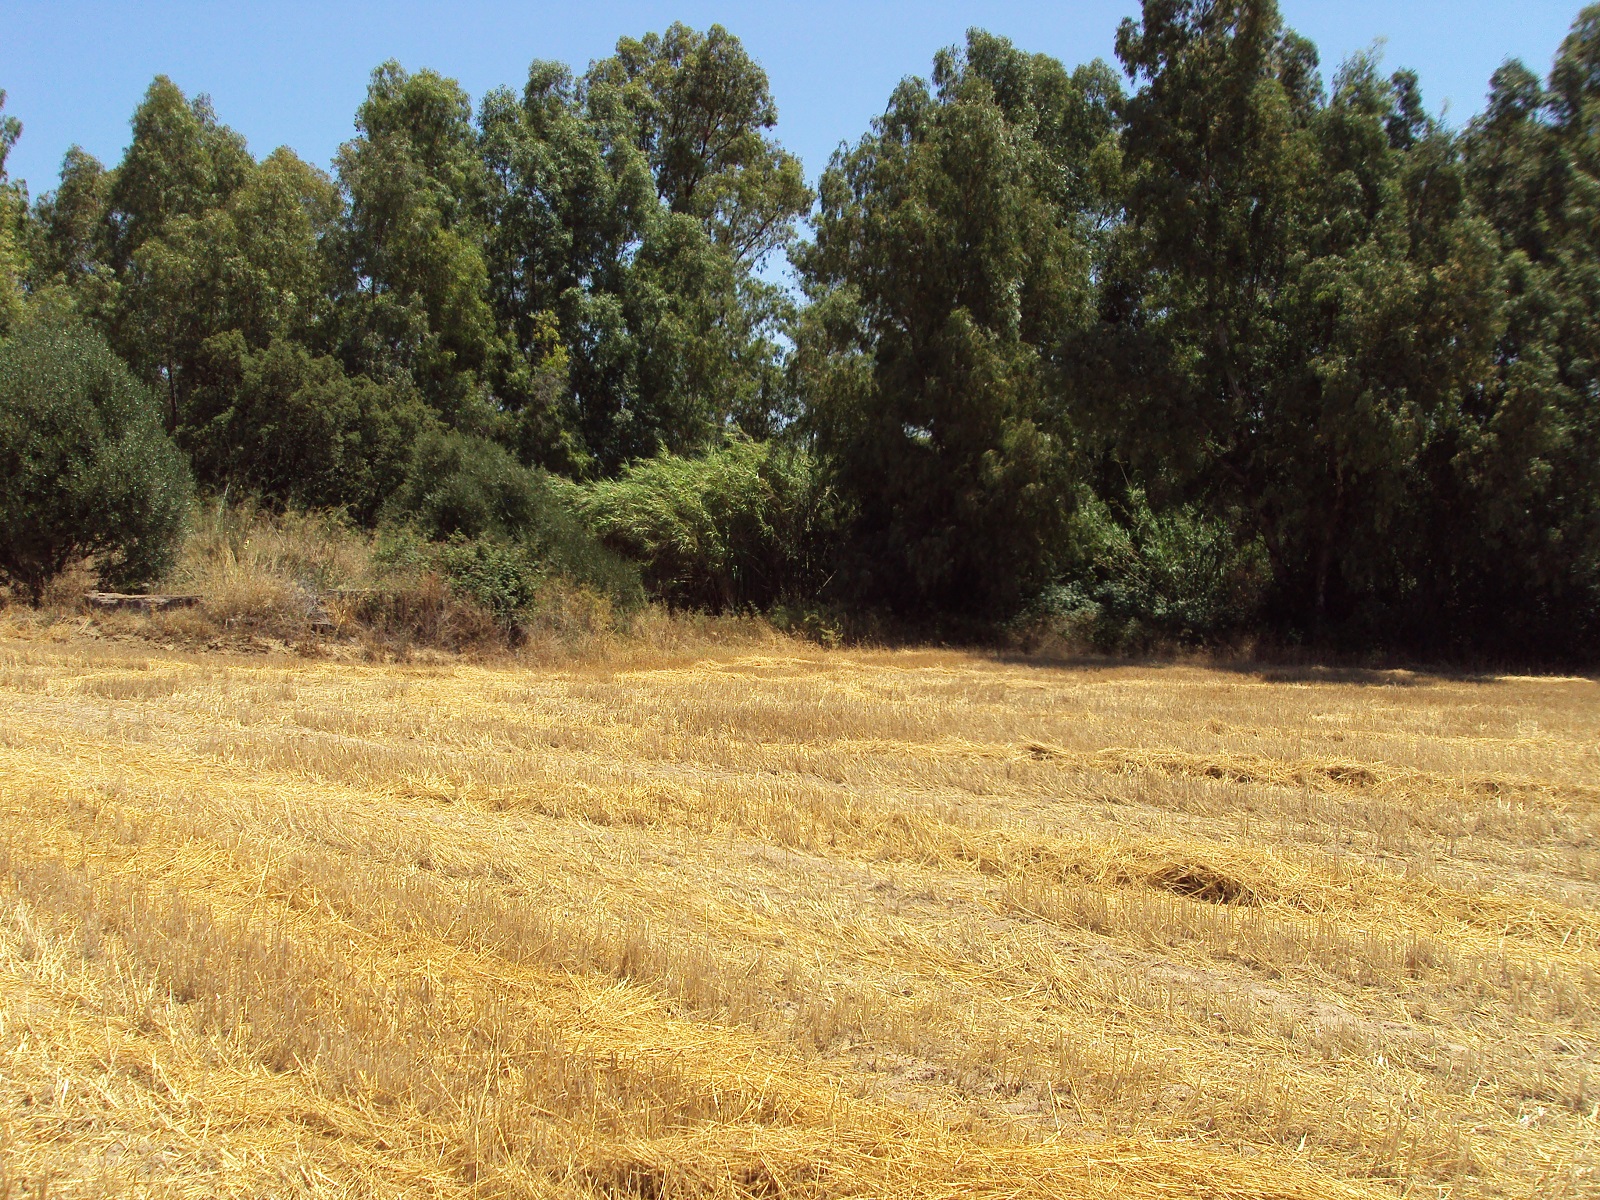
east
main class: Cropland
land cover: Durum wheat
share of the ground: > 75 %
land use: Agriculture (excluding fallow land and kitchen gardens)
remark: Harvested field
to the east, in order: Durum wheat; Broadleaved woodland; Rivers and streams; Olive groves
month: June
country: ES
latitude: 37.3727
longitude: -6.8761
